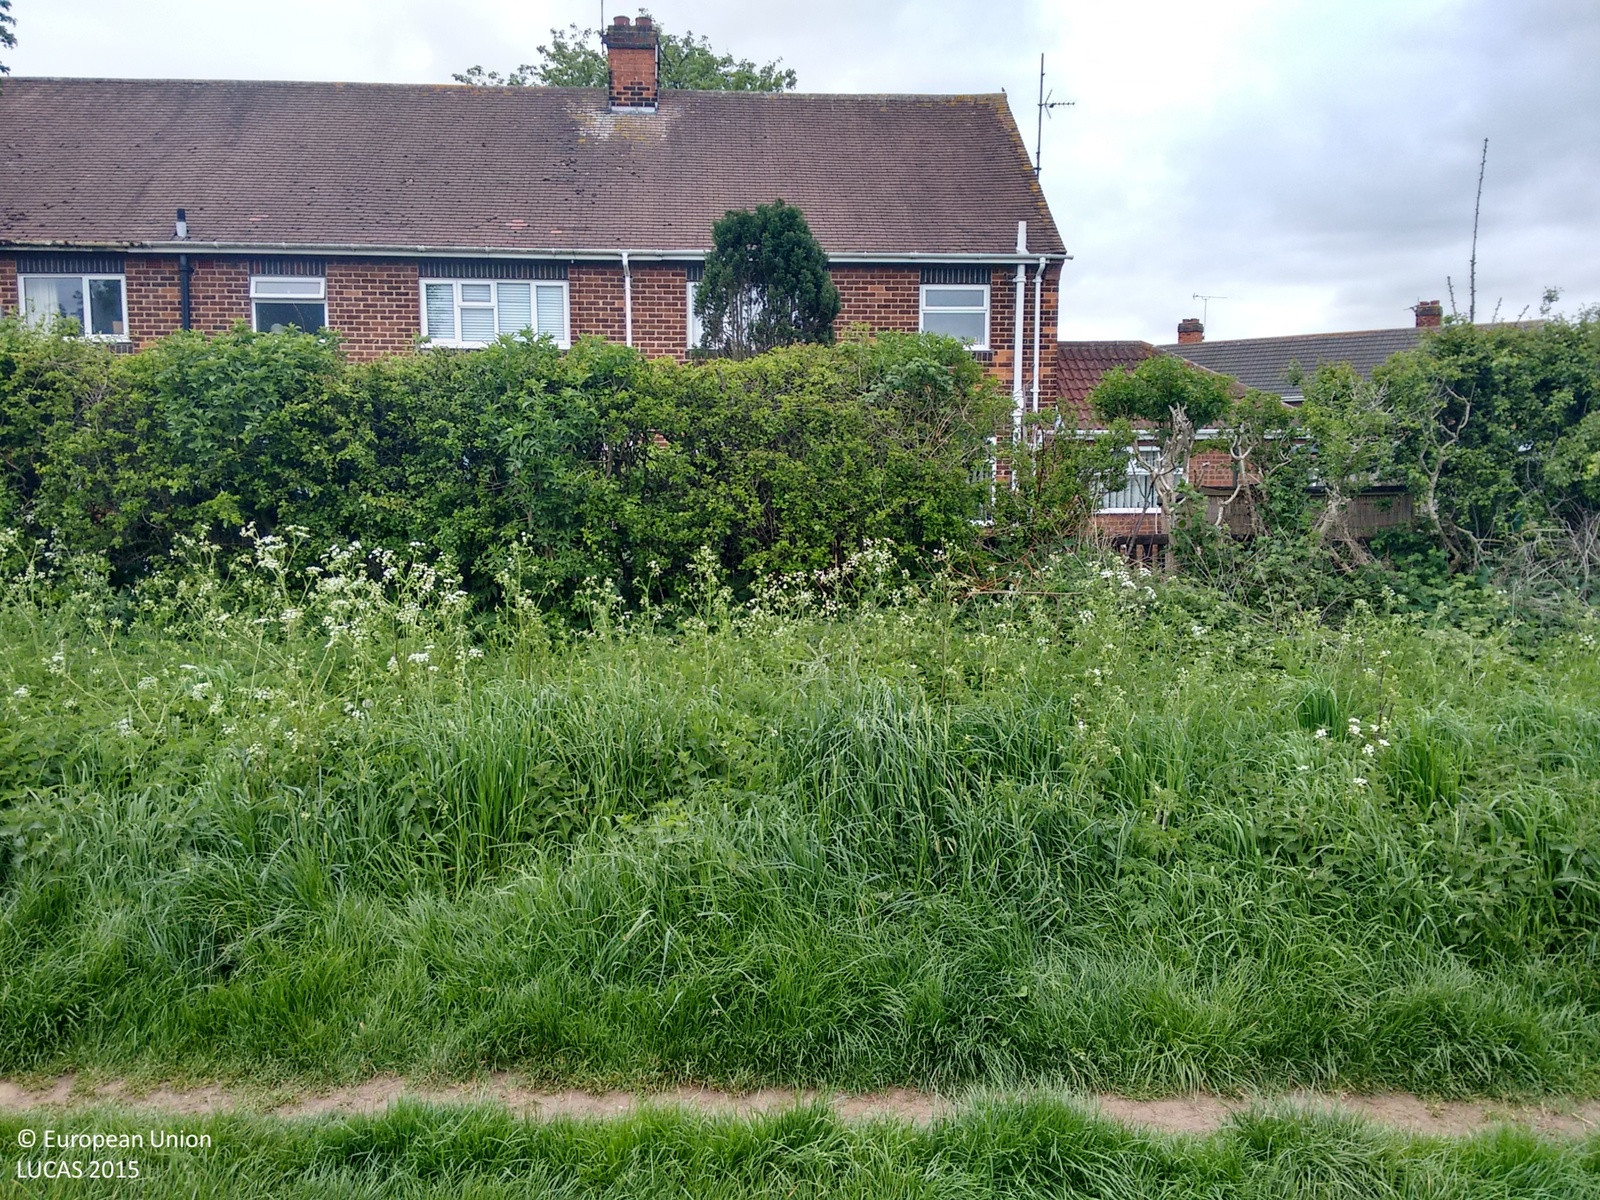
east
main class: Cropland
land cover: Barley
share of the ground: > 75 %
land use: Agriculture (excluding fallow land and kitchen gardens)
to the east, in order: Barley; Grass margins; Tracks; Grassland without tree/shrub cover; Artificial constructions in urban areas
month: May
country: GB
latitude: 53.7818
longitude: -0.2477
